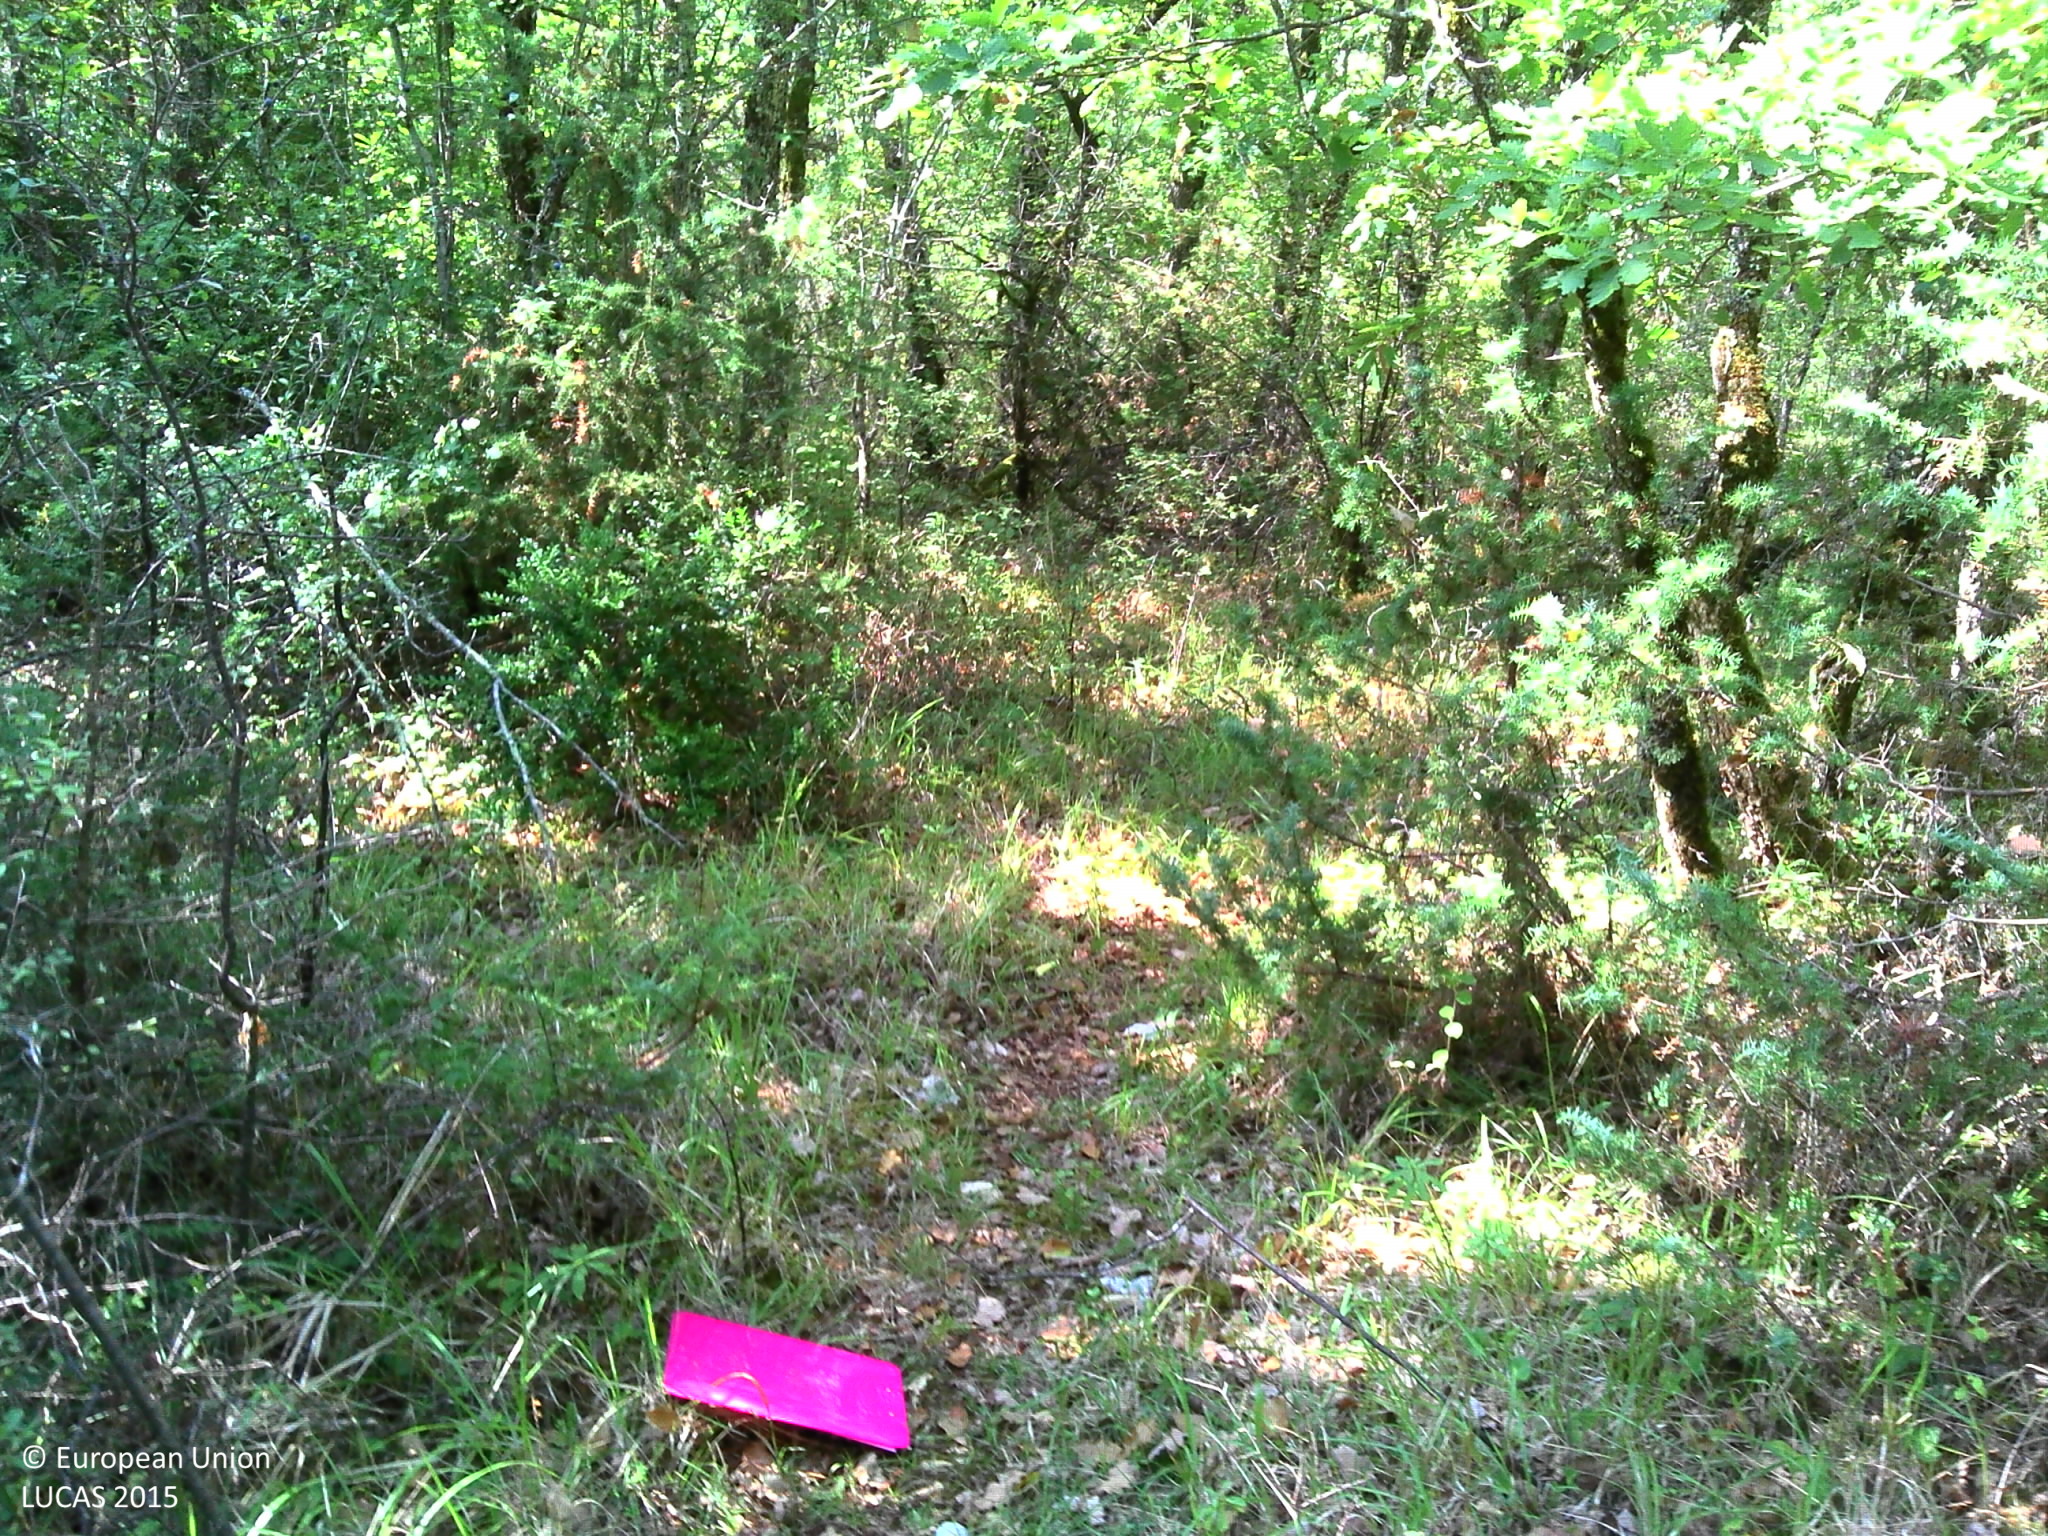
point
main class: Woodland
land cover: Broadleaved woodland
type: mesophytic deciduous forest
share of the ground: > 75 %
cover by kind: broadleaved forest trees 90 %, coniferous forest trees 10 %
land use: Agriculture (excluding fallow land and kitchen gardens)
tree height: > 5 m
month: August
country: FR
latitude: 44.2490
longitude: 1.6471
